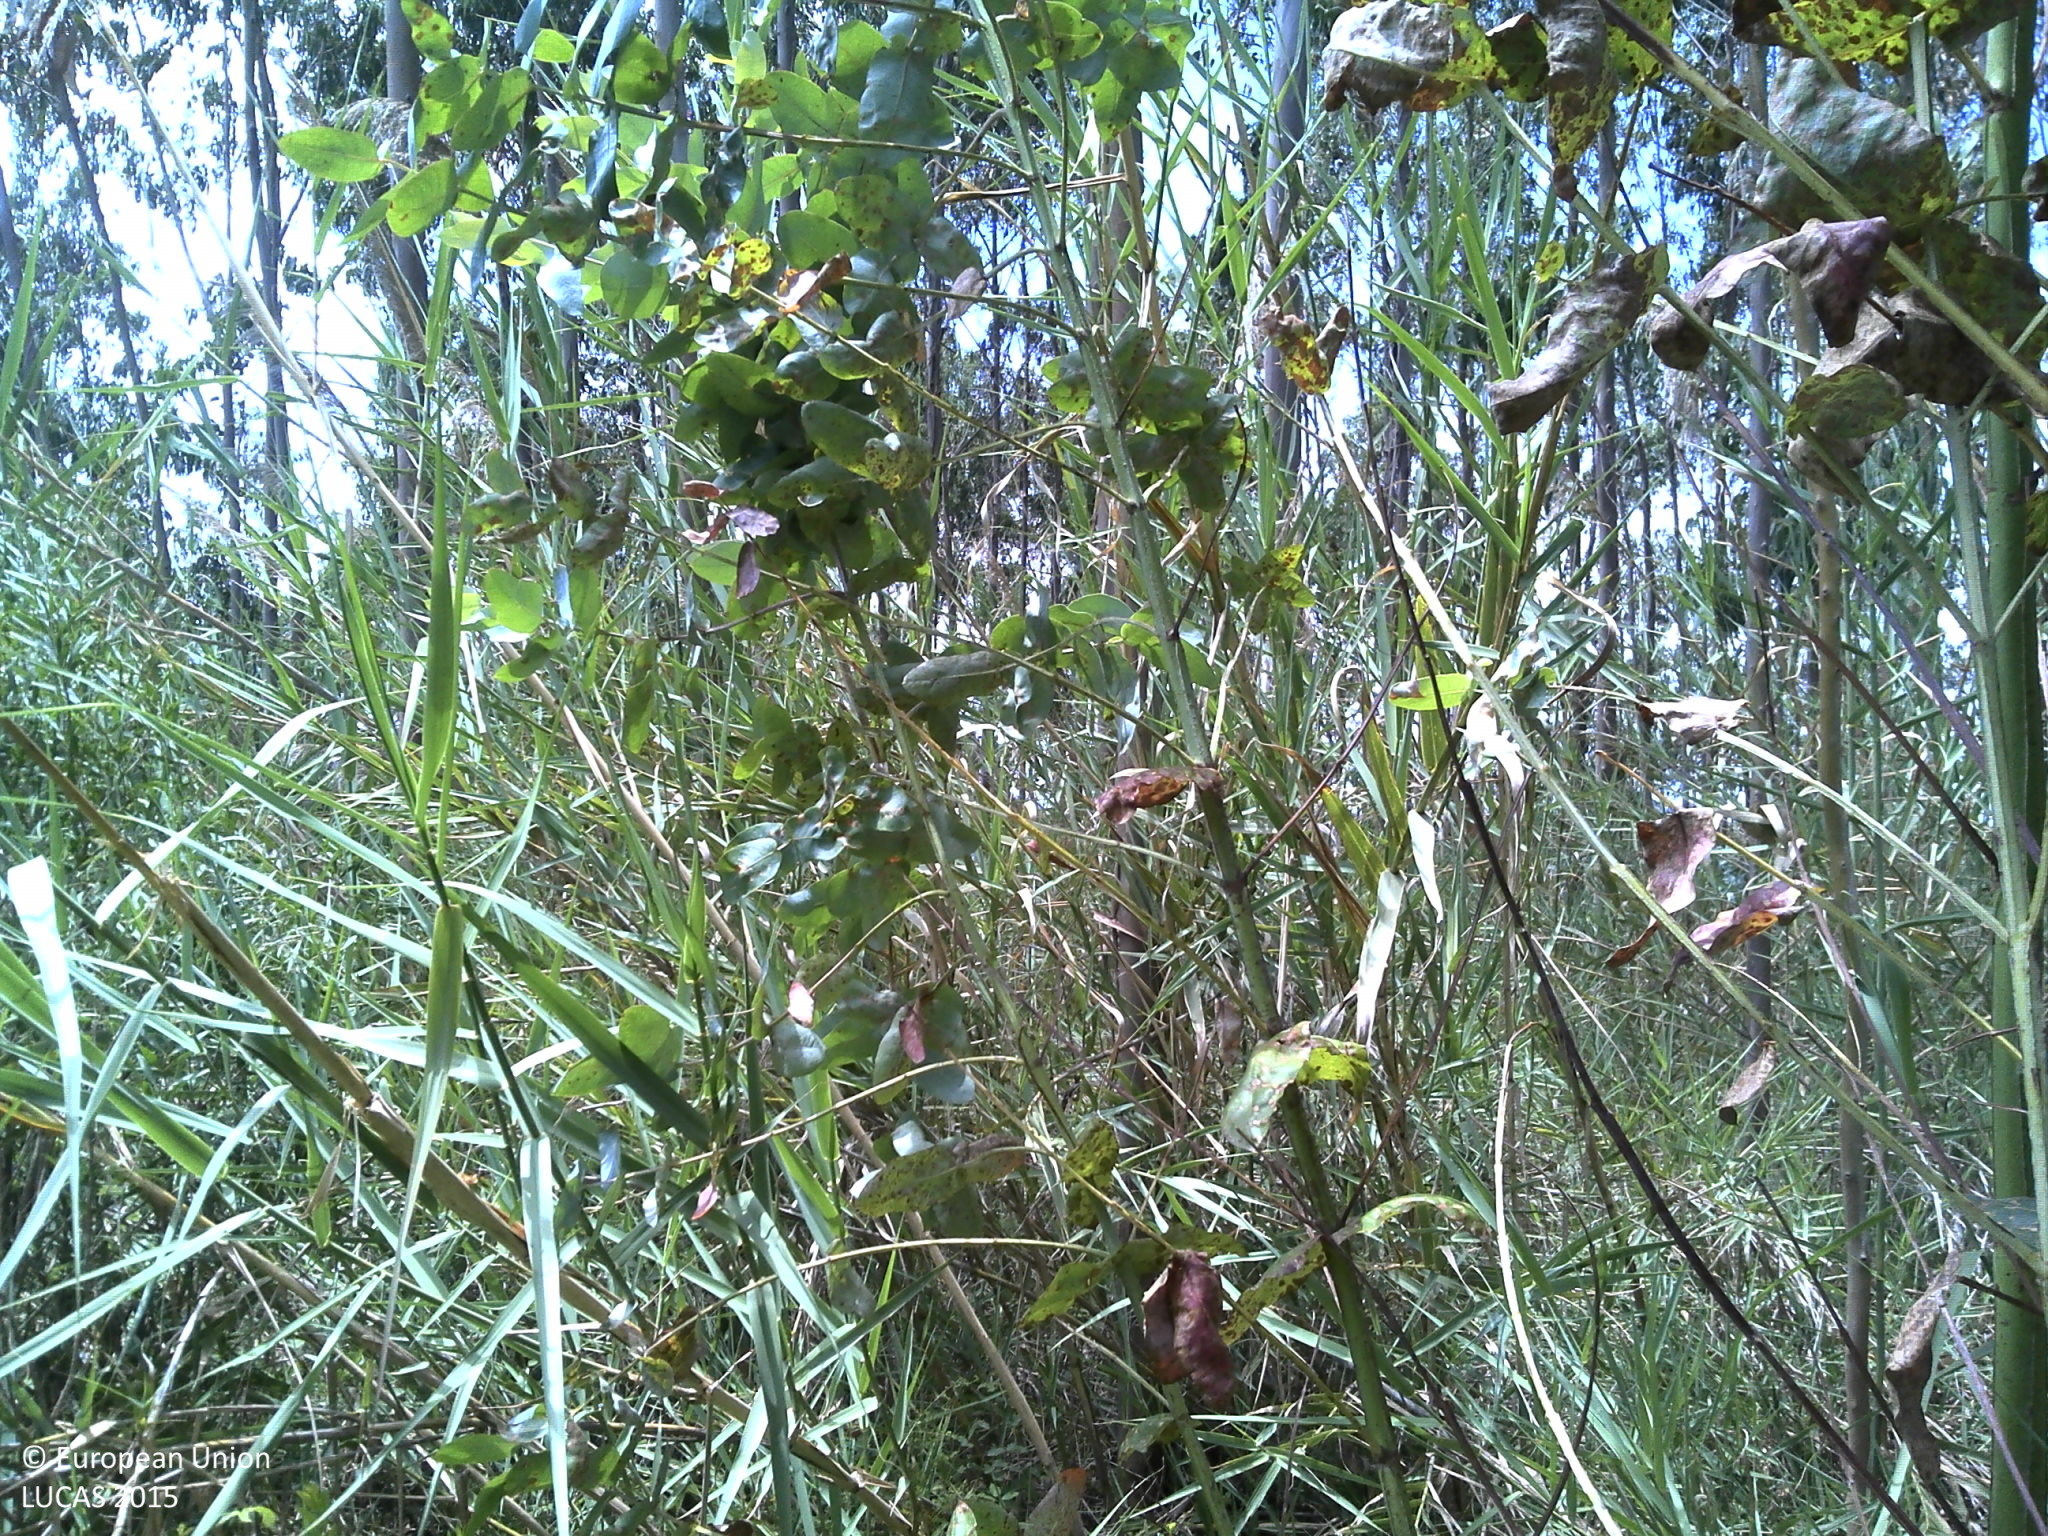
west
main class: Woodland
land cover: Broadleaved woodland
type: exotic forest
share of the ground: 50 - 75 %
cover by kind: broadleaved forest trees 60 %, shrubs 30 %, unconsolidated bare surface 10 %
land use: Forestry
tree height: > 5 m
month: June
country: PT
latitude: 39.2631
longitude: -9.2711
